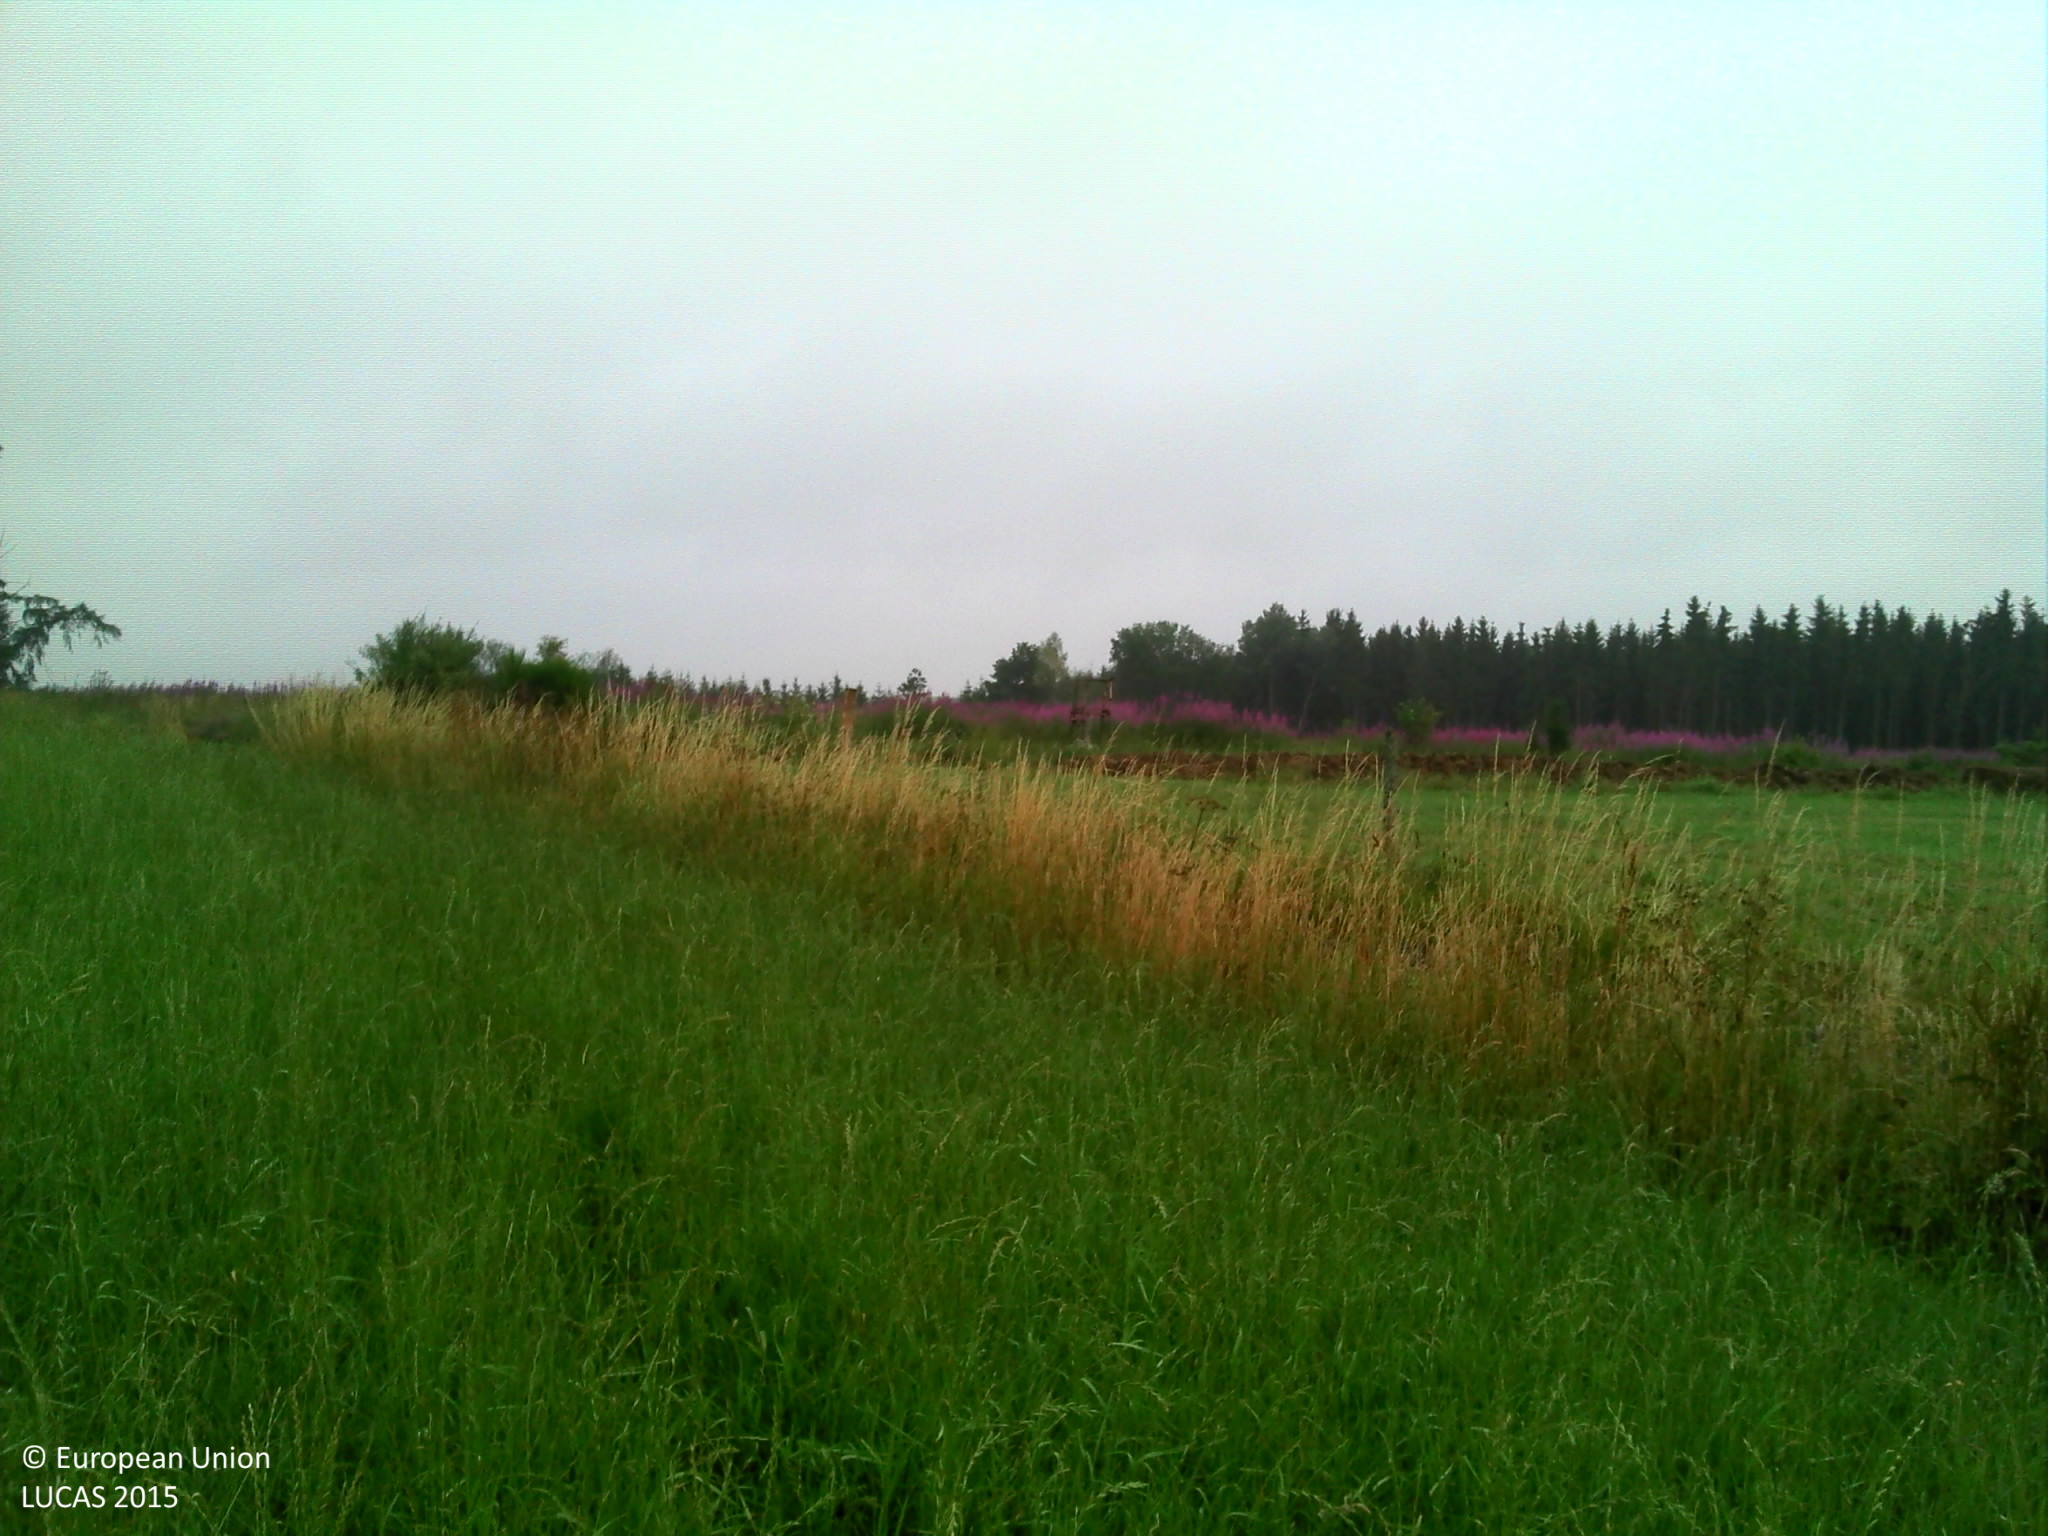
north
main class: Grassland
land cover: Grassland without tree/shrub cover
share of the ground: > 75 %
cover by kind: herbaceous plants 100 %
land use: Agriculture (excluding fallow land and kitchen gardens)
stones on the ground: < 10 %
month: July
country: BE
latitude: 50.0865
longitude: 5.7359
